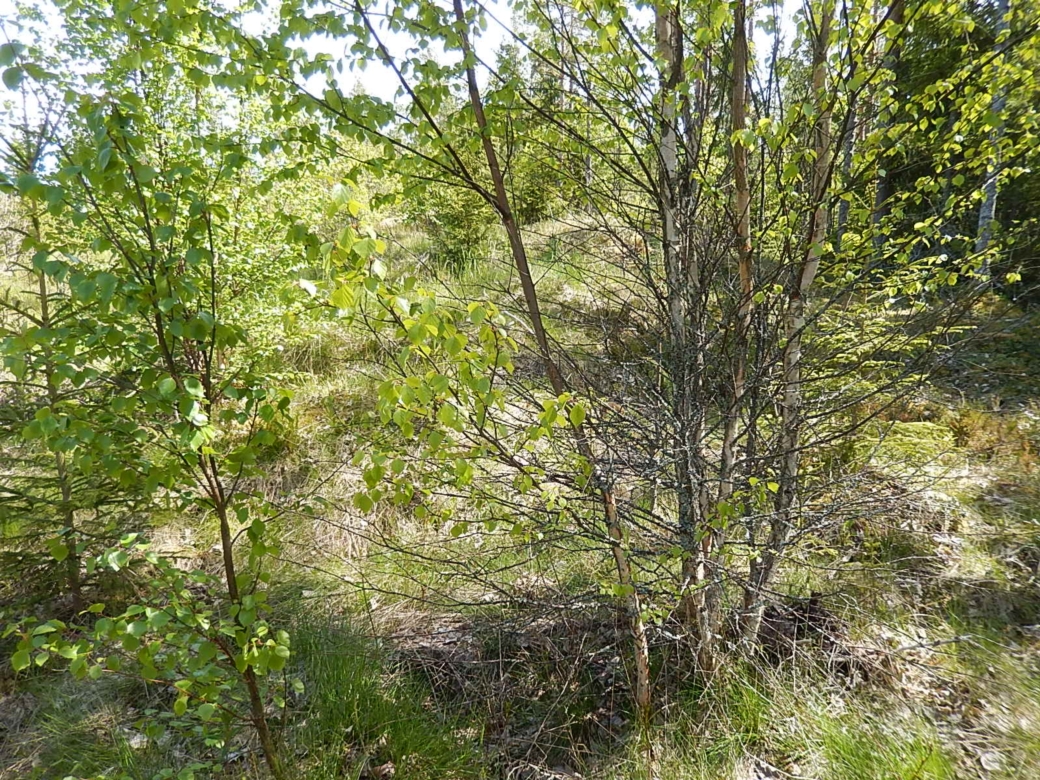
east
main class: Woodland
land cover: Other mixed woodland
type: boreal forest
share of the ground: 50 - 75 %
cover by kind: herbaceous plants 35 %, broadleaved forest trees 30 %, coniferous forest trees 20 %, lichens and mosses 10 %, shrubs 5 %
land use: Forestry
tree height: > 5 m
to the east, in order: Other mixed woodland; Pine dominated coniferous woodland; Spruce dominated mixed woodland; Ditches and canals; Spruce dominated mixed woodland; Ditches and canals; Spruce dominated mixed woodland; Ditches and canals; Spruce dominated mixed woodland
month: June
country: FI
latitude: 62.0987
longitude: 21.4821
